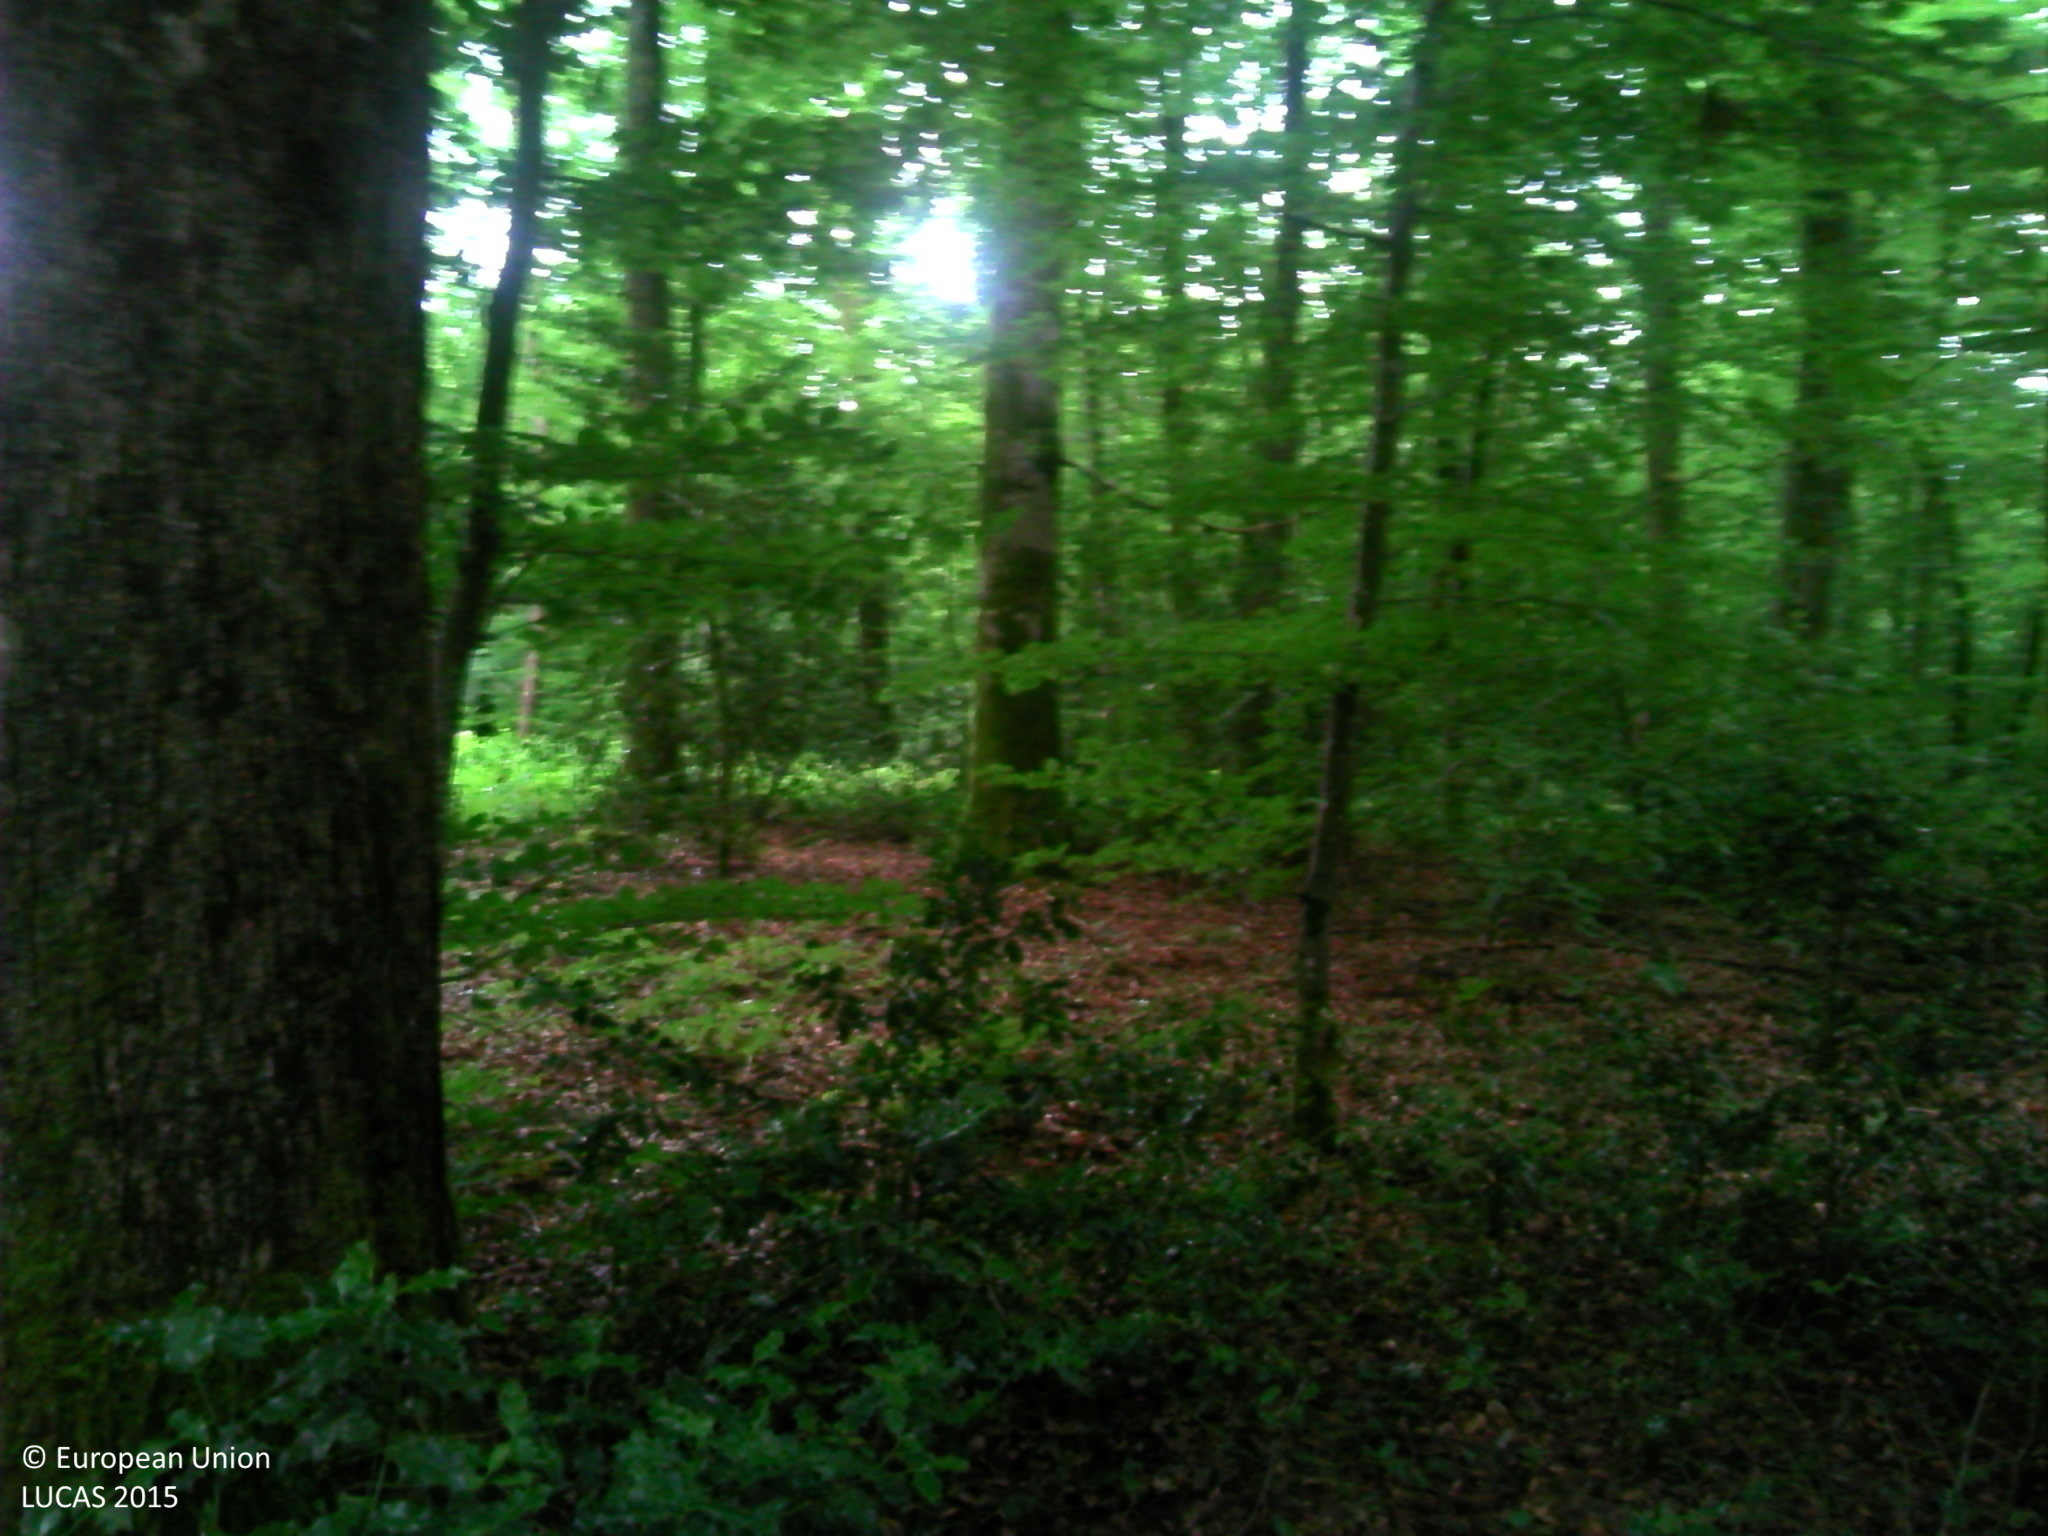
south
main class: Woodland
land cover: Broadleaved woodland
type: beech forest
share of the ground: > 75 %
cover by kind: broadleaved forest trees 90 %, shrubs 5 %, herbaceous plants 5 %
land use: Forestry
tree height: > 5 m
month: June
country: FR
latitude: 47.6943
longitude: 6.3371
